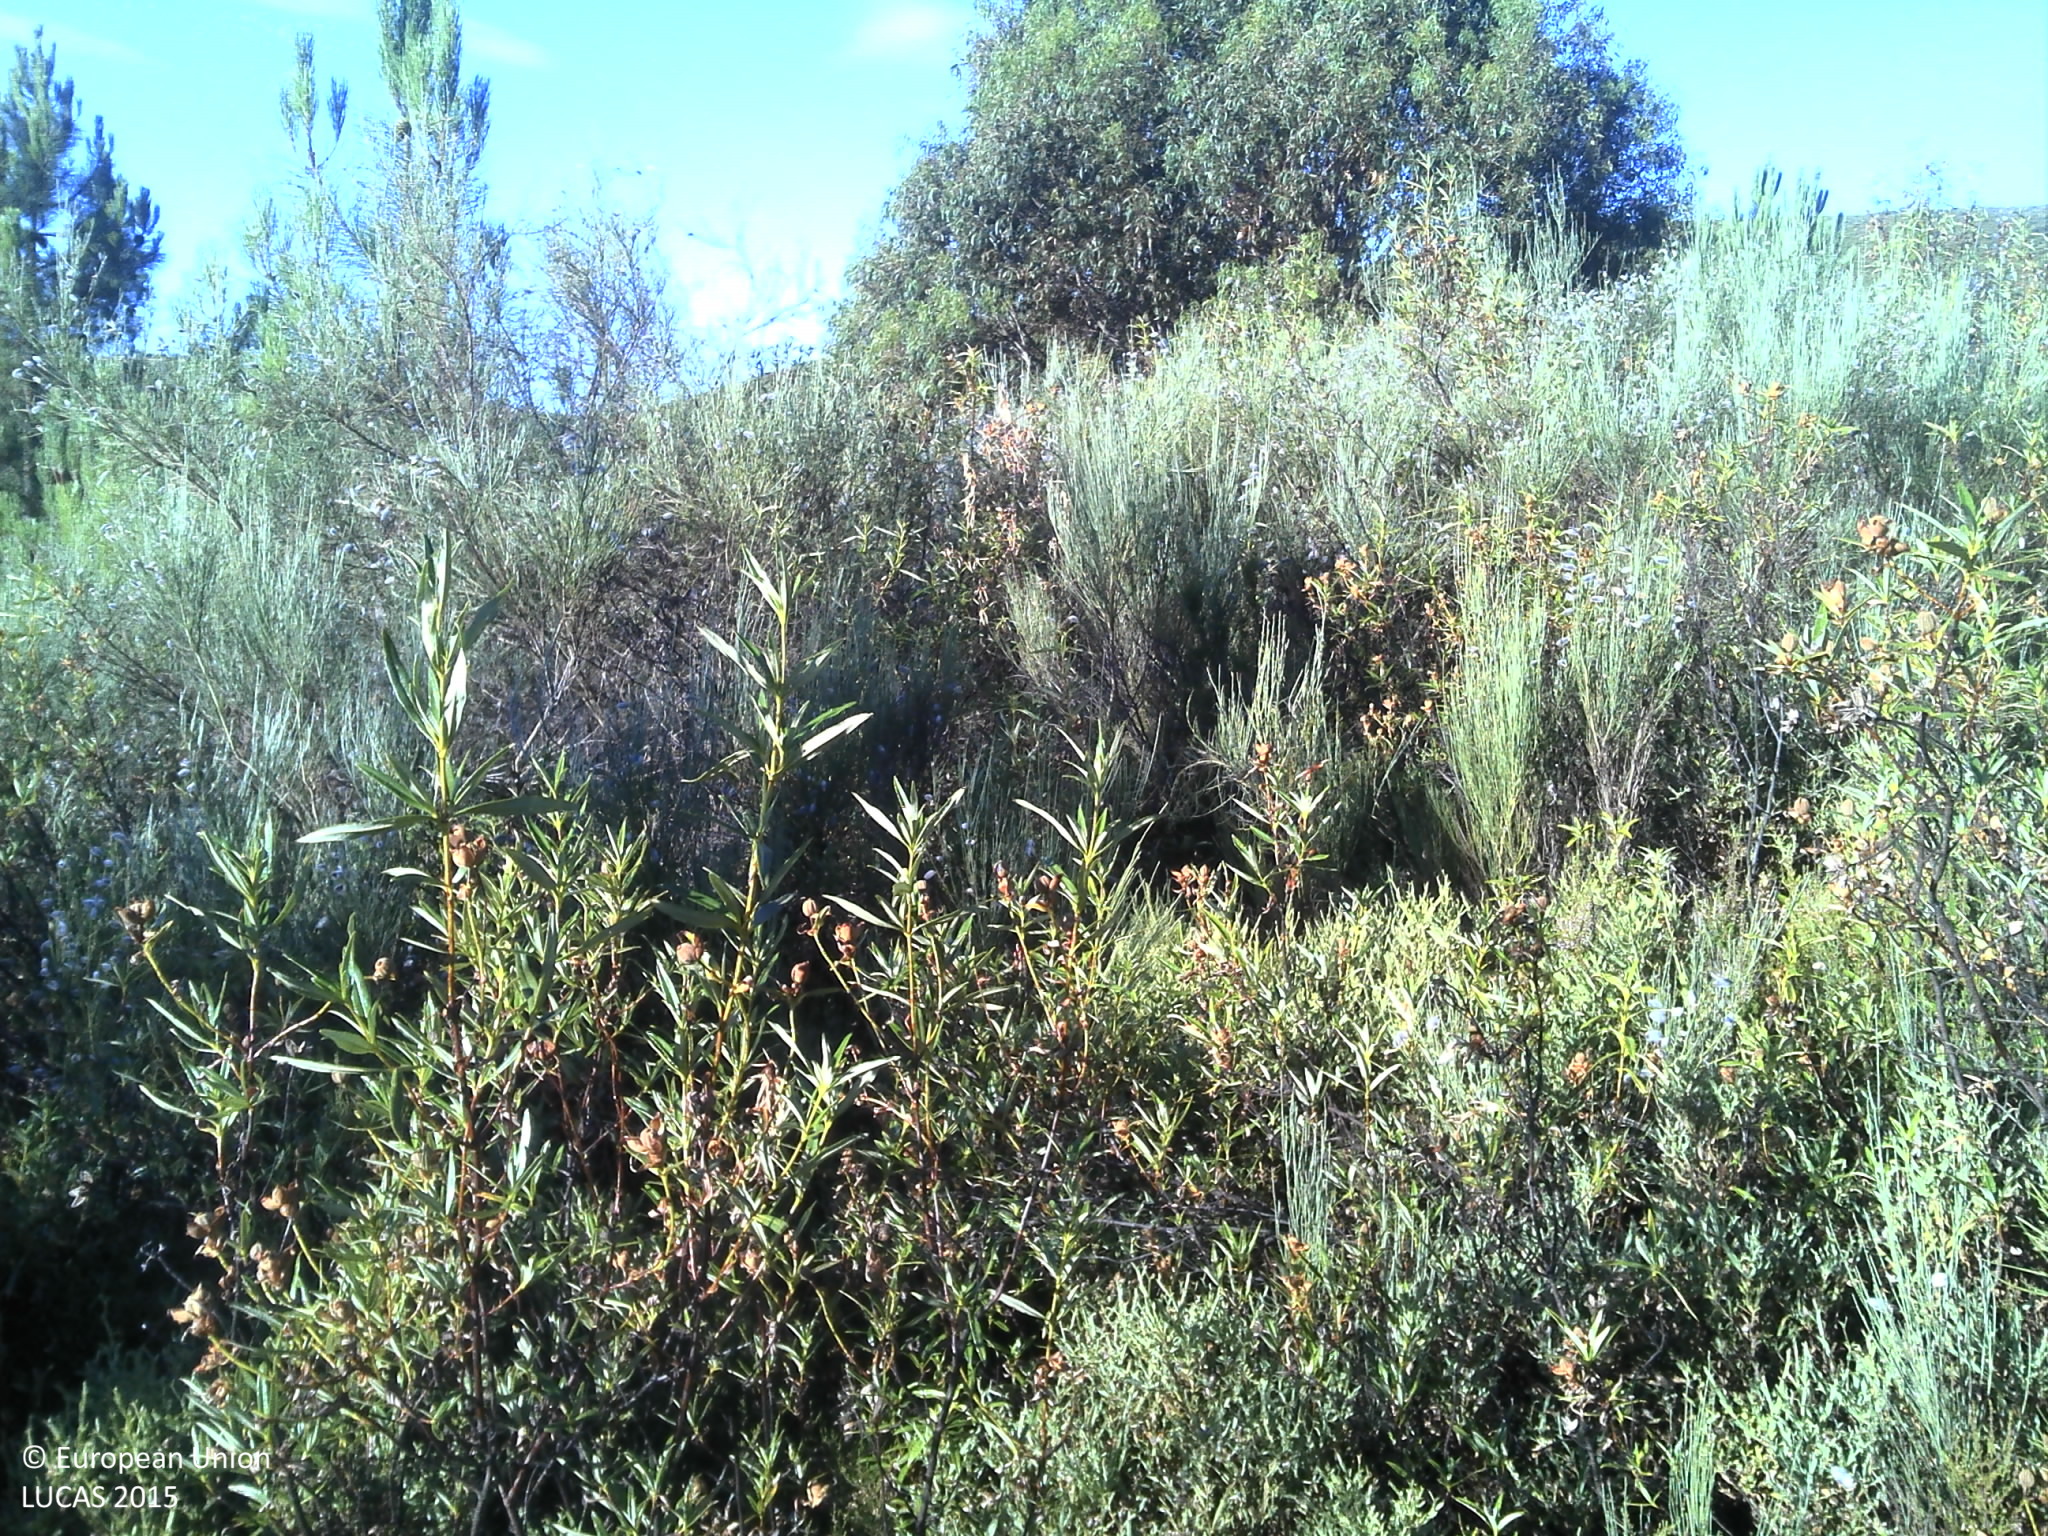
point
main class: Shrubland
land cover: Shrubland without tree cover
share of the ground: 50 - 75 %
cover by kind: shrubs 65 %, unconsolidated bare surface 35 %
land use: Forestry
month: July
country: PT
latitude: 40.0943
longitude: -7.6430
